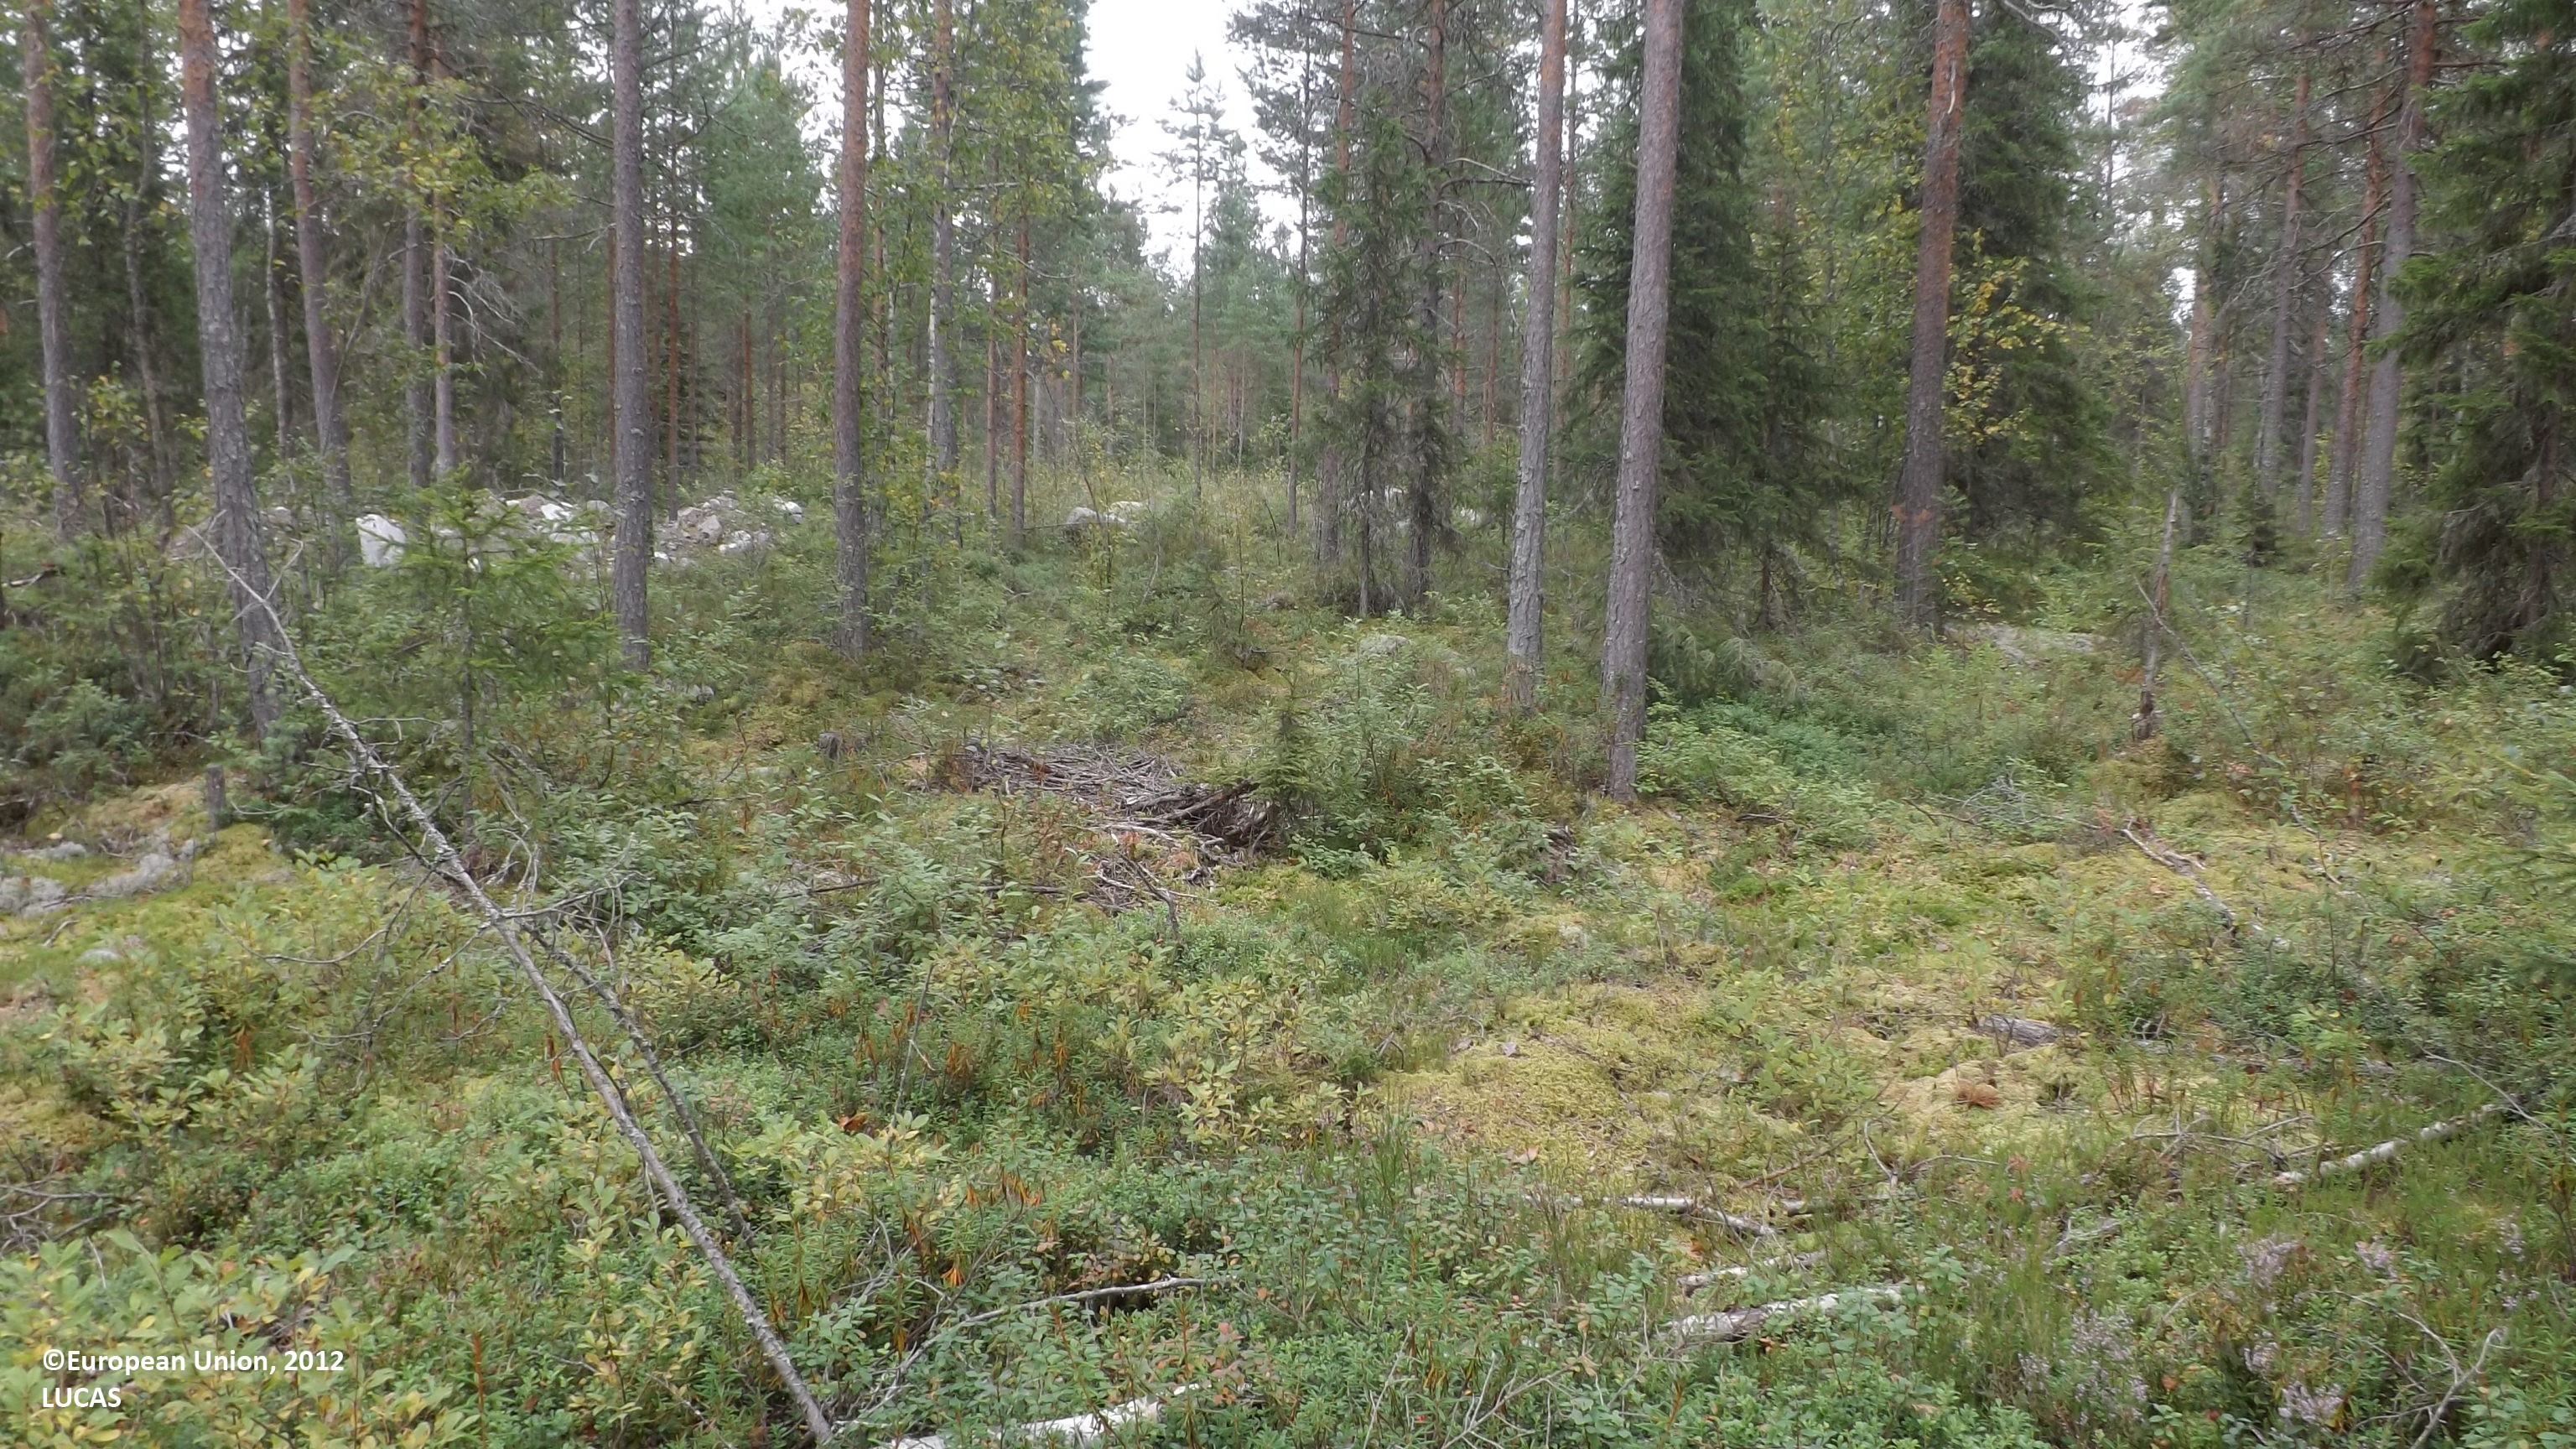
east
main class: Woodland
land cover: Other mixed woodland
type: boreal forest
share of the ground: 25 - 50 %
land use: Forestry
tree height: > 5 m
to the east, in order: Other mixed woodland; Pine dominated mixed woodland; Ditches and canals; Pine dominated mixed woodland; Other mixed woodland; Ditches and canals; Pine dominated mixed woodland; Grassland with sparse tree/shrub cover; Ditches and canals; Spruce dominated mixed woodland; Ditches and canals; Other mixed woodland; Pine dominated mixed woodland
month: August
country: FI
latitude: 63.9639
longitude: 23.9294
